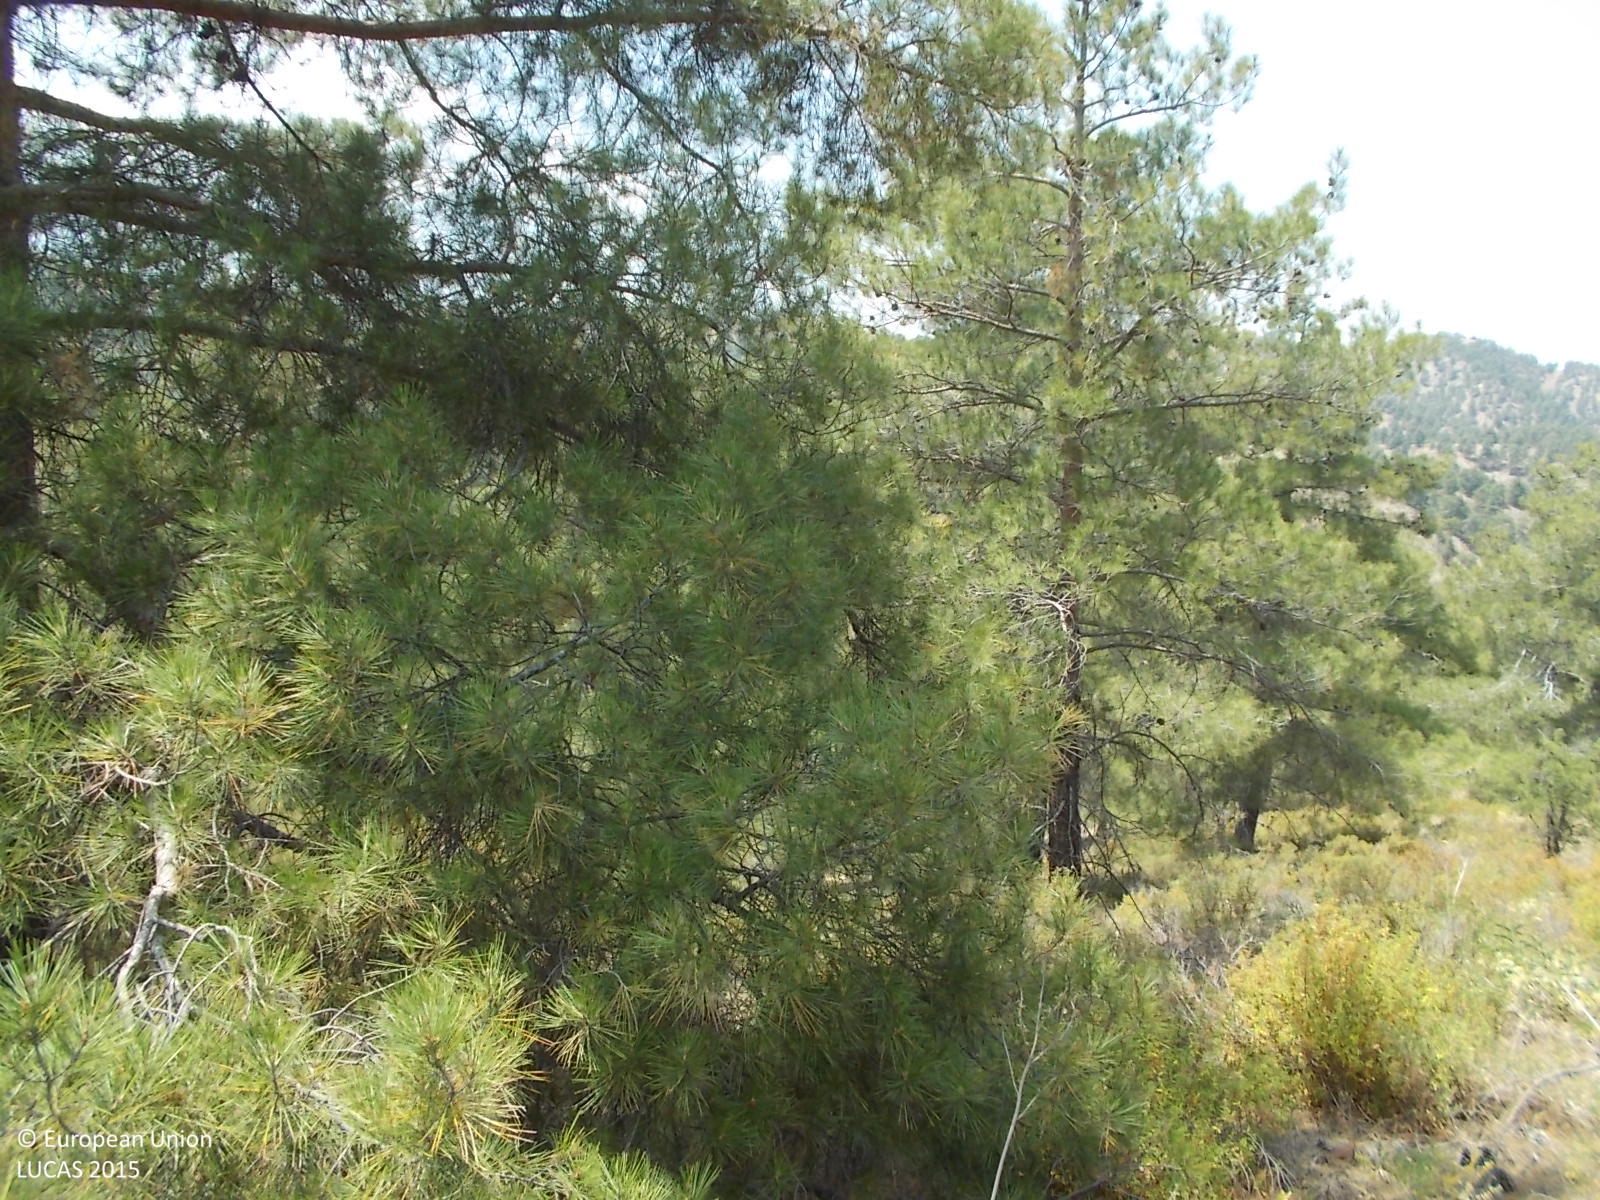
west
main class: Woodland
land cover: Pine dominated coniferous woodland
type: coniferous forest of the mediterranean region
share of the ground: 10 - 25 %
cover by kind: shrubs 55 %, unconsolidated bare surface 25 %, coniferous forest trees 20 %
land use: Forestry
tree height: > 5 m
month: June
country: CY
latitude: 34.9998
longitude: 32.9282
